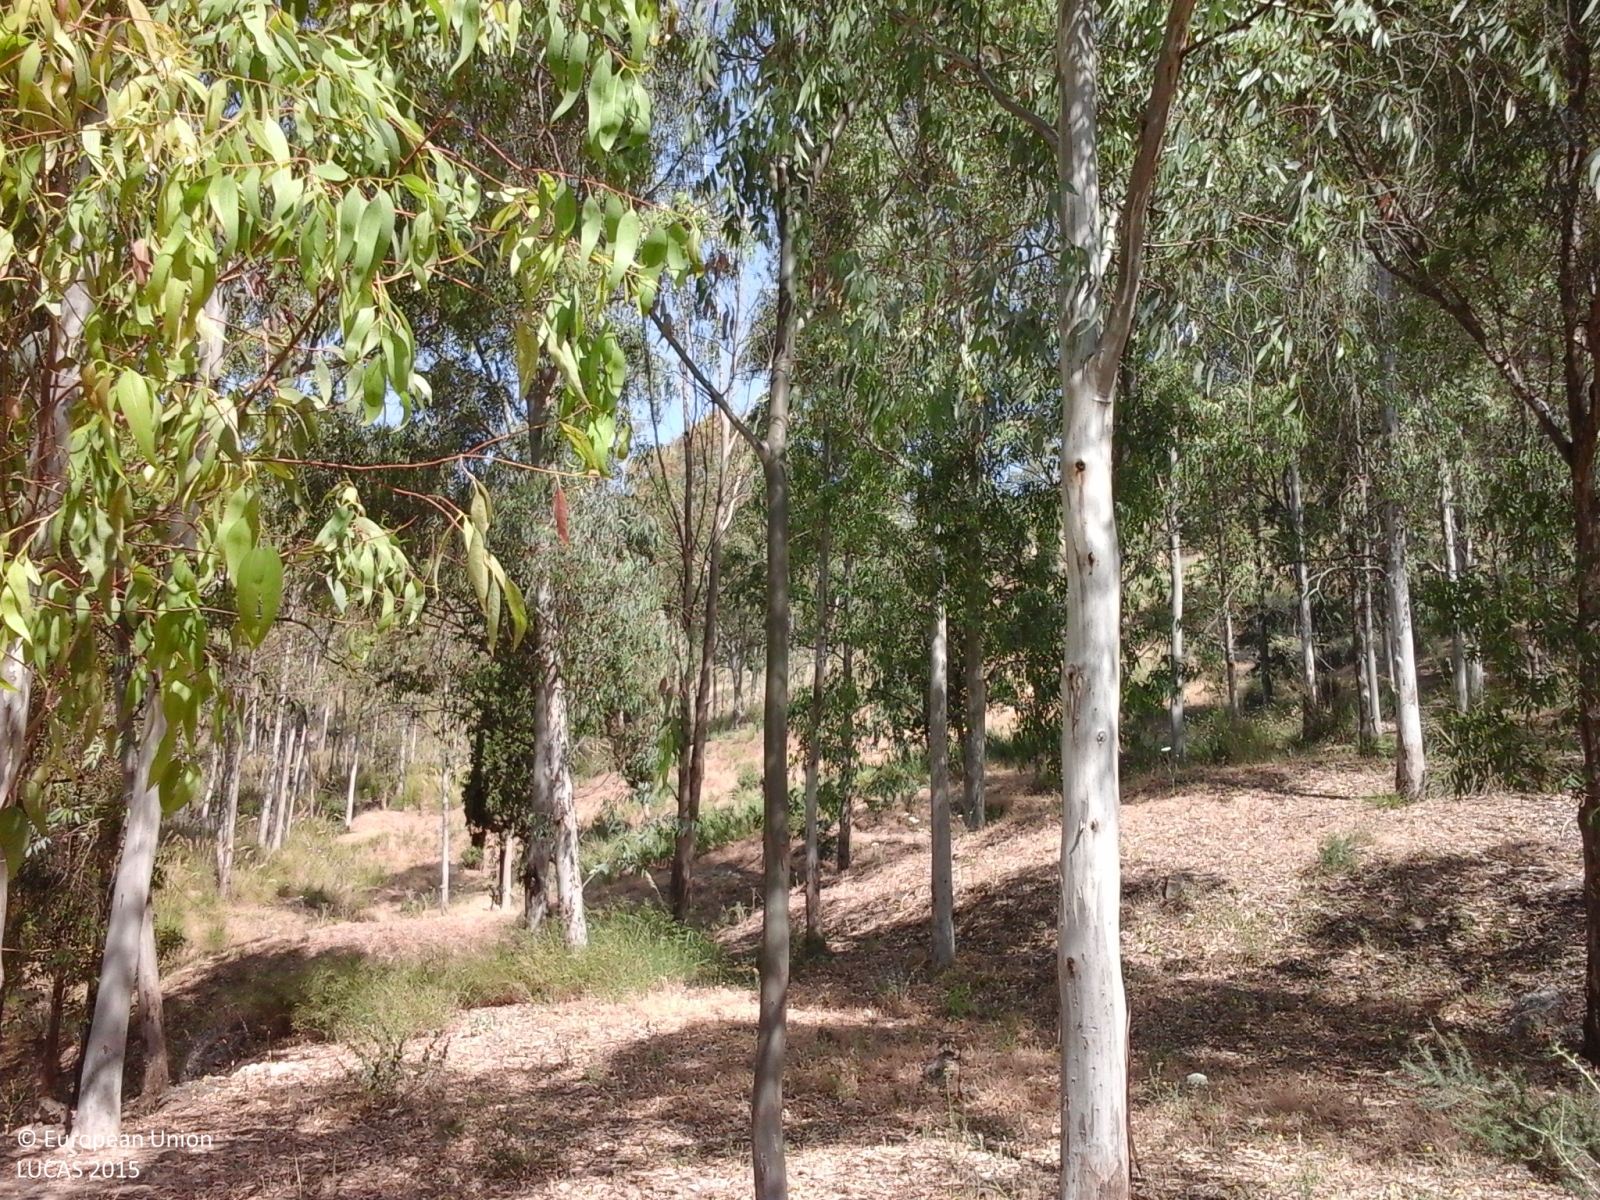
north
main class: Woodland
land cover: Broadleaved woodland
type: broadleaved evergreen forest
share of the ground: > 75 %
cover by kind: broadleaved forest trees 80 %, herbaceous plants 20 %
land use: Forestry
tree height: > 5 m
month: June
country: IT
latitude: 37.4975
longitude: 13.6035
